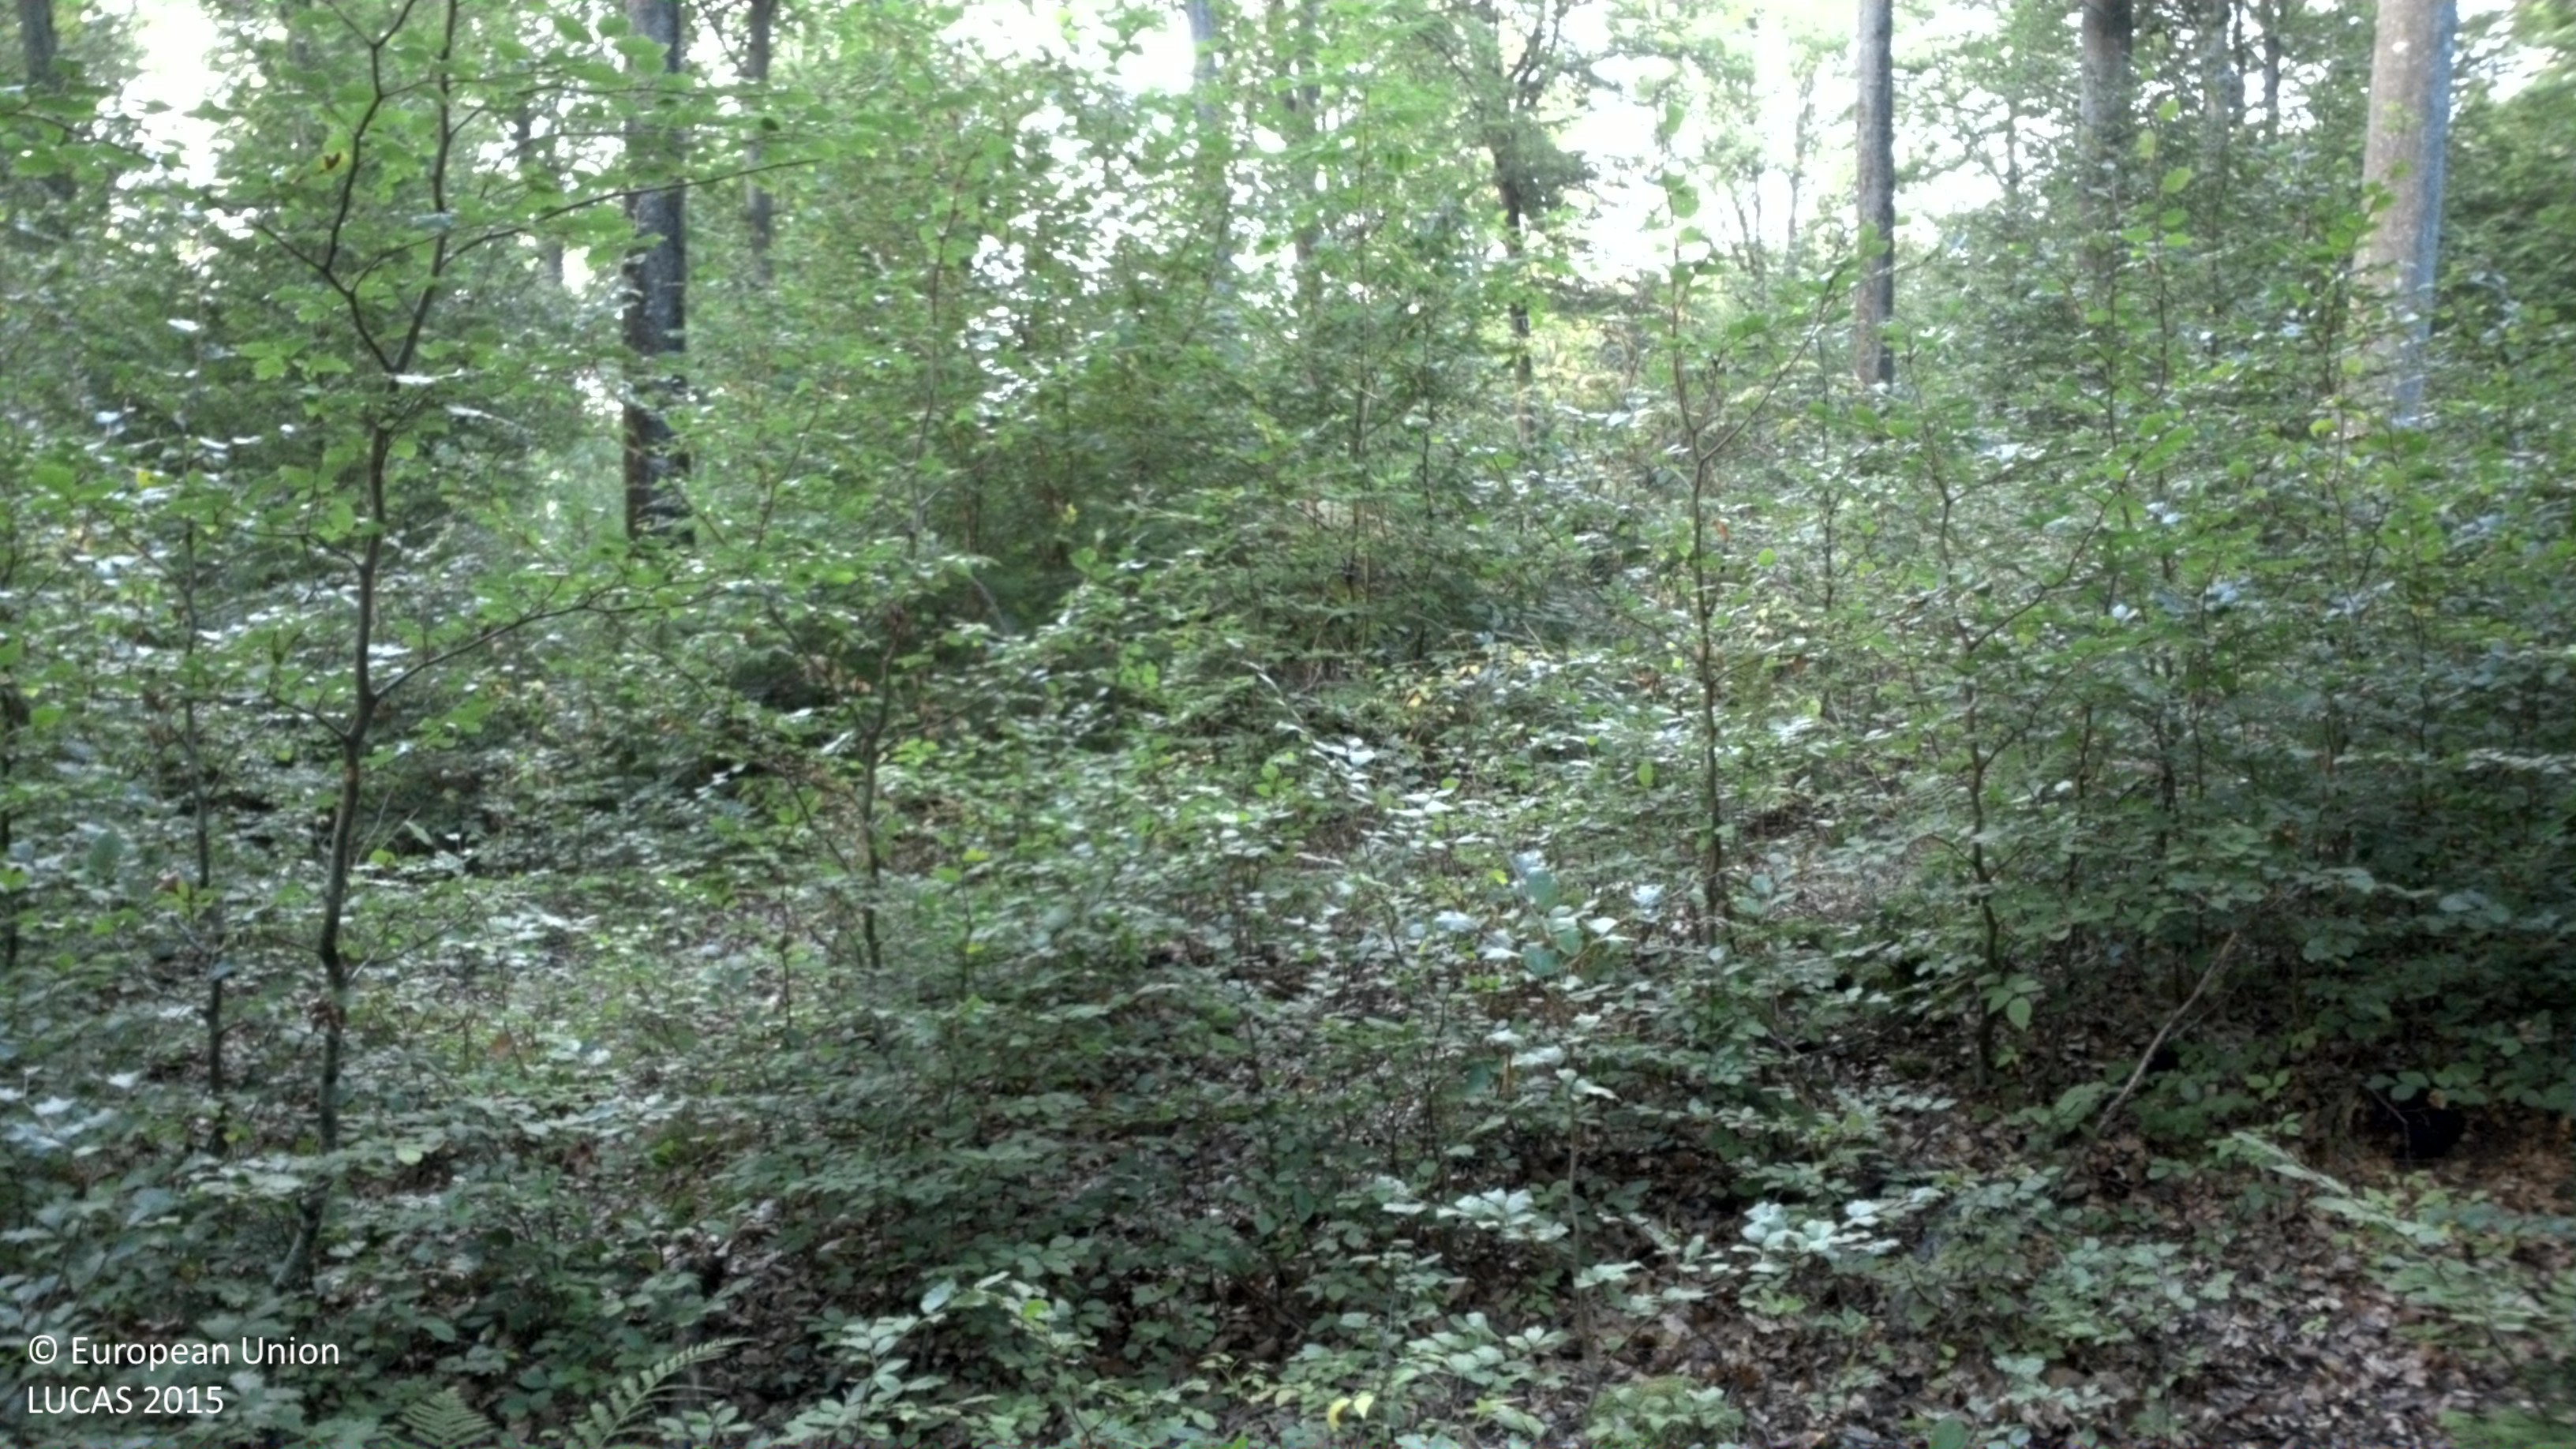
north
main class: Woodland
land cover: Broadleaved woodland
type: beech forest
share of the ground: > 75 %
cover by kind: broadleaved forest trees 80 %, herbaceous plants 5 %, lichens and mosses 5 %
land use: Forestry
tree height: > 5 m
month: September
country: SE
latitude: 56.1182
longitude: 14.2279
